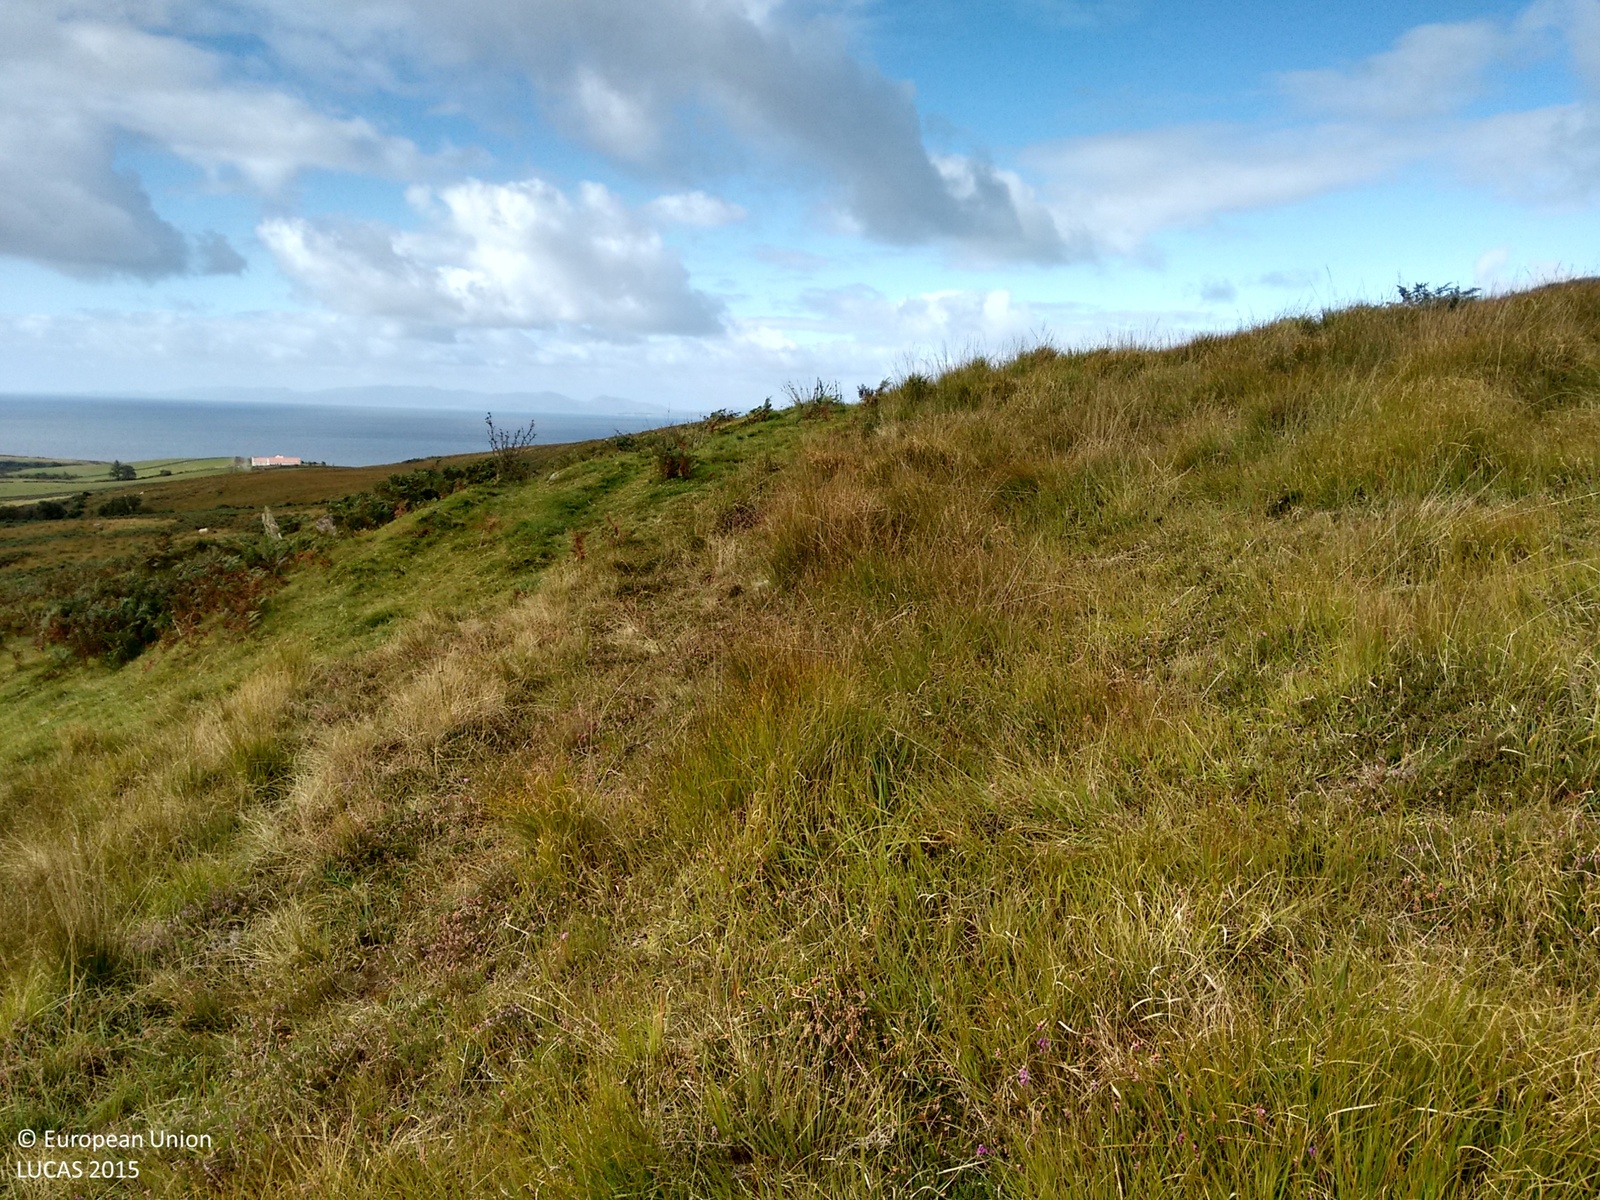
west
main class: Shrubland
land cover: Shrubland without tree cover
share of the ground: > 75 %
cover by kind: herbaceous plants 60 %, shrubs 40 %
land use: Agriculture (excluding fallow land and kitchen gardens)
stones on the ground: < 10 %
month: September
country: GB
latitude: 55.8447
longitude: -5.6341
